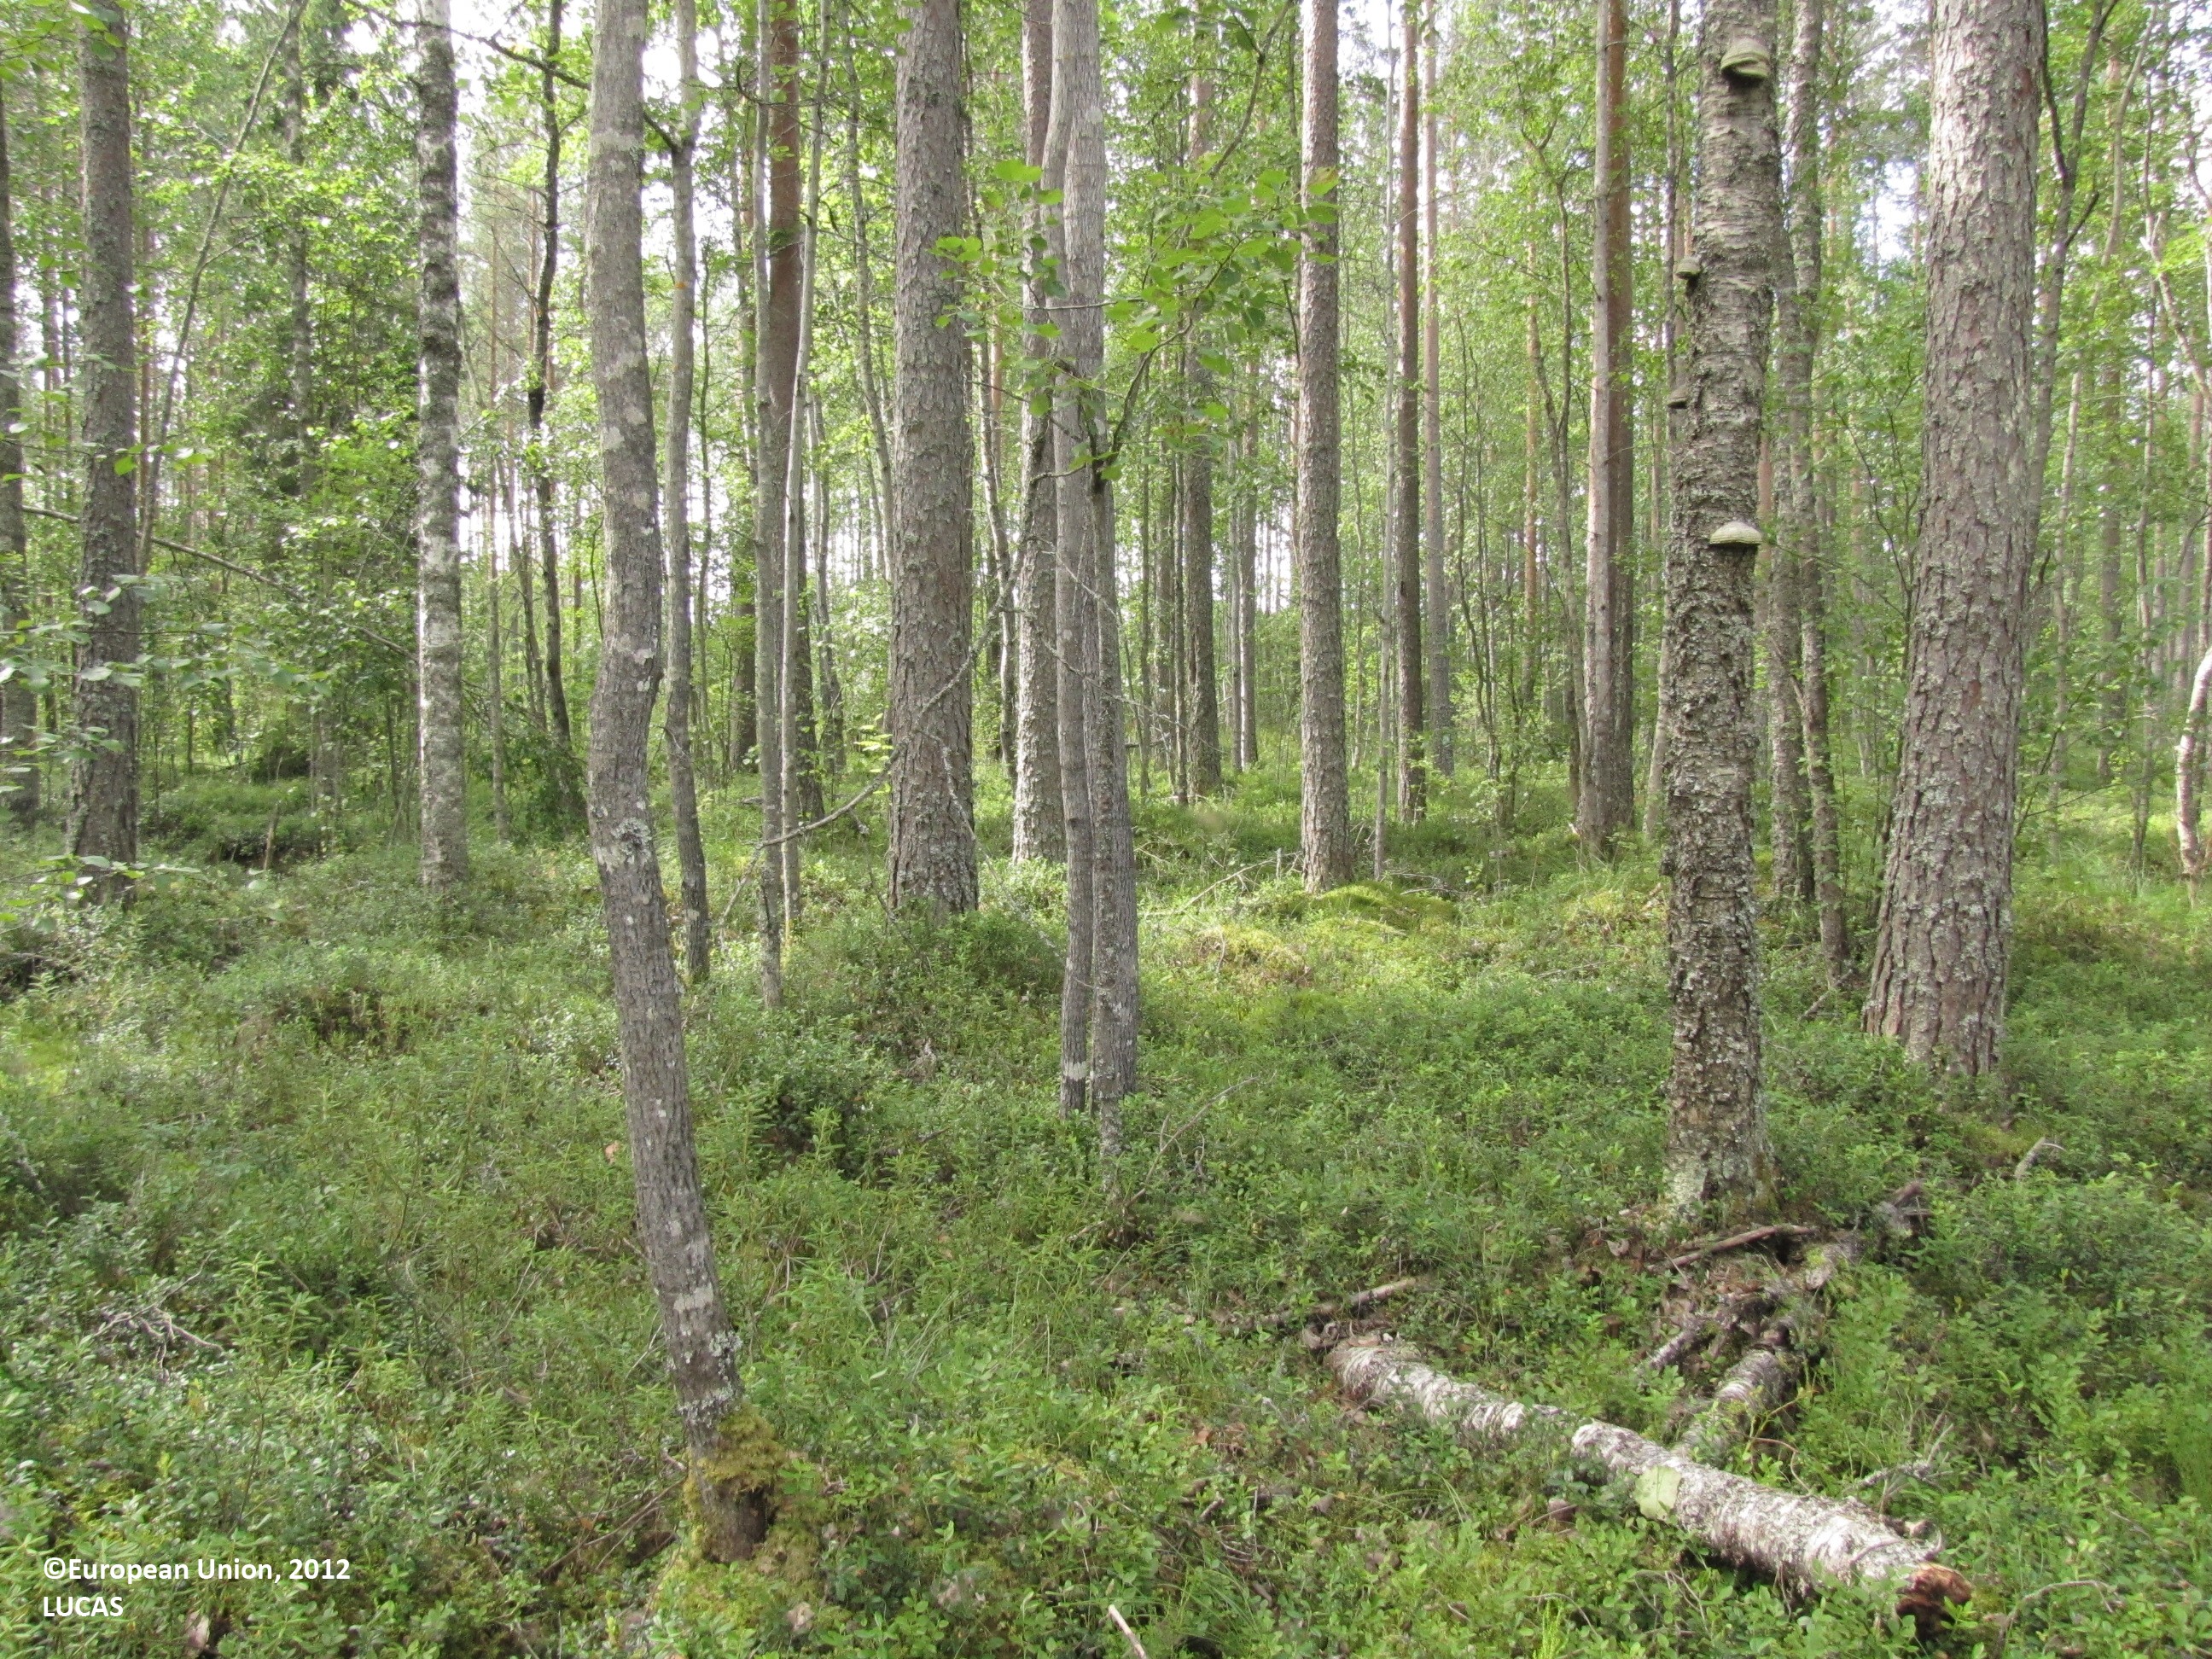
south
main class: Woodland
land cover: Pine dominated coniferous woodland
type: mire and swamp forests
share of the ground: > 75 %
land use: Forestry
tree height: > 5 m
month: July
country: FI
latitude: 62.4087
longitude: 23.2474
